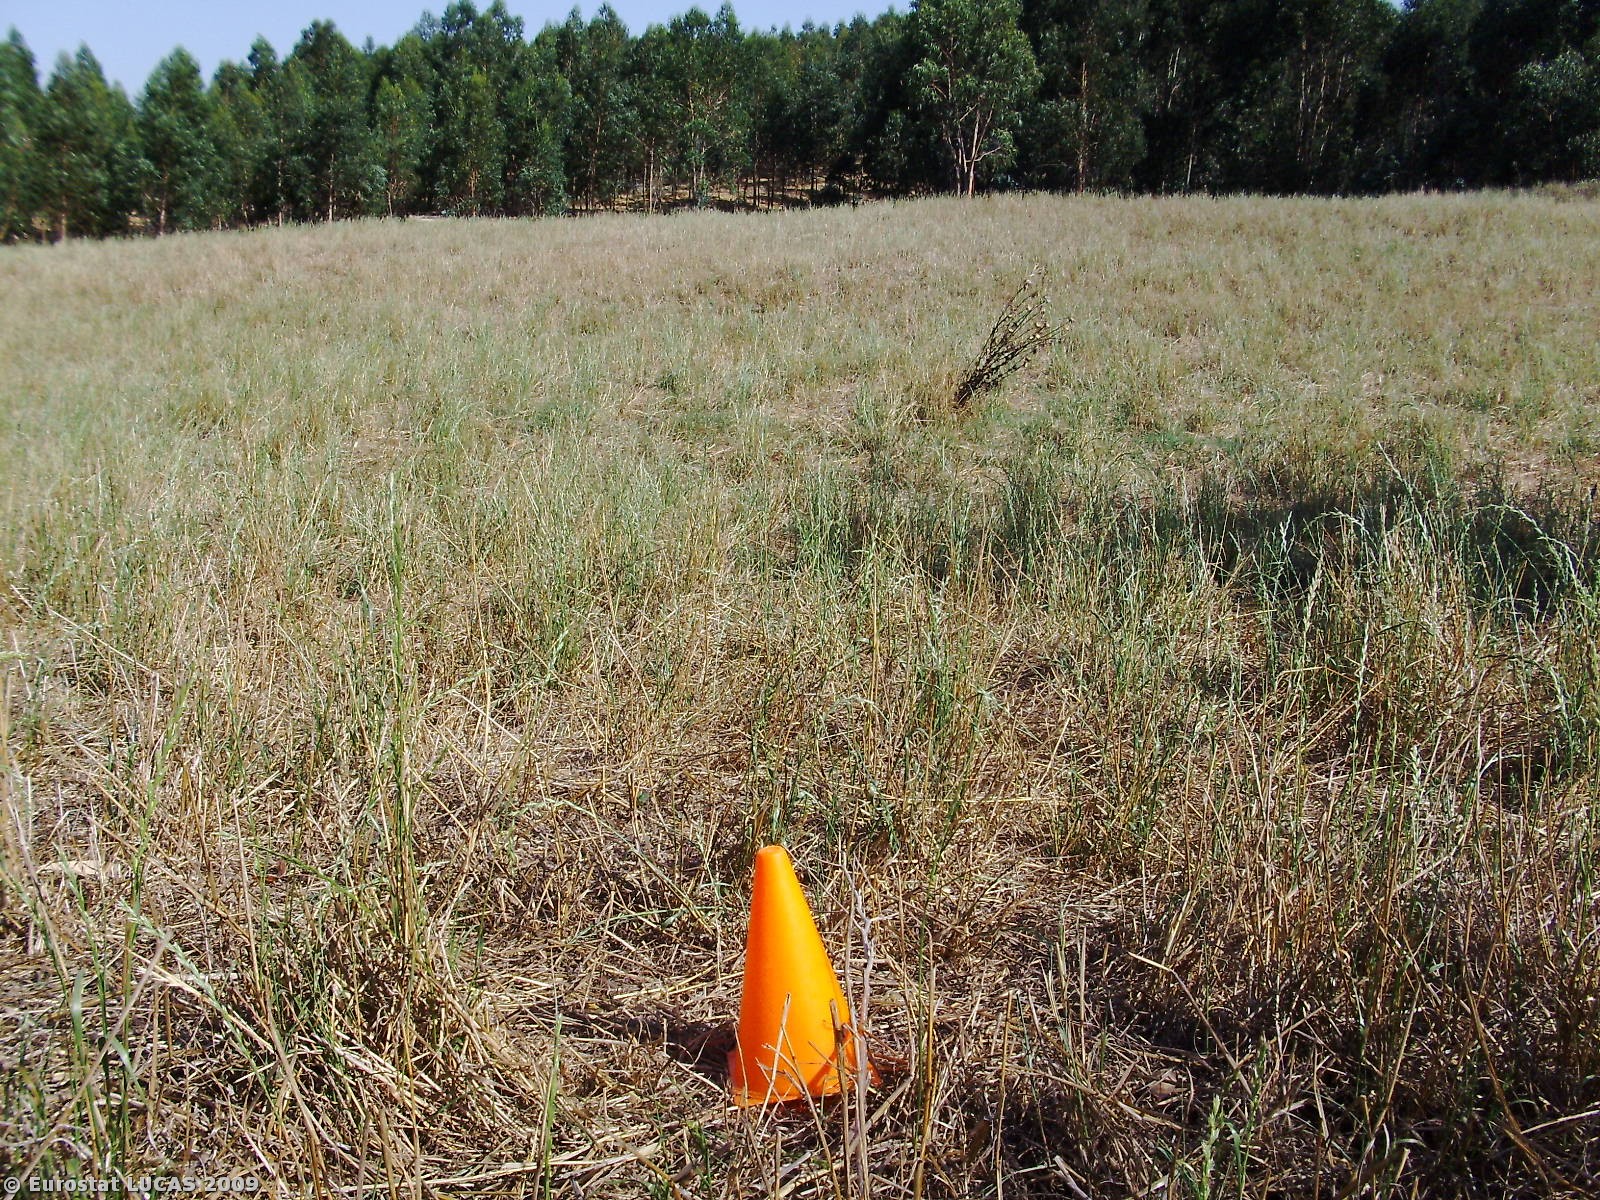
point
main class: Grassland
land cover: Grassland with sparse tree/shrub cover
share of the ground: > 75 %
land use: Agriculture (excluding fallow land and kitchen gardens)
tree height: > 5 m
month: July
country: PT
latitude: 39.3312
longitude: -8.8375
